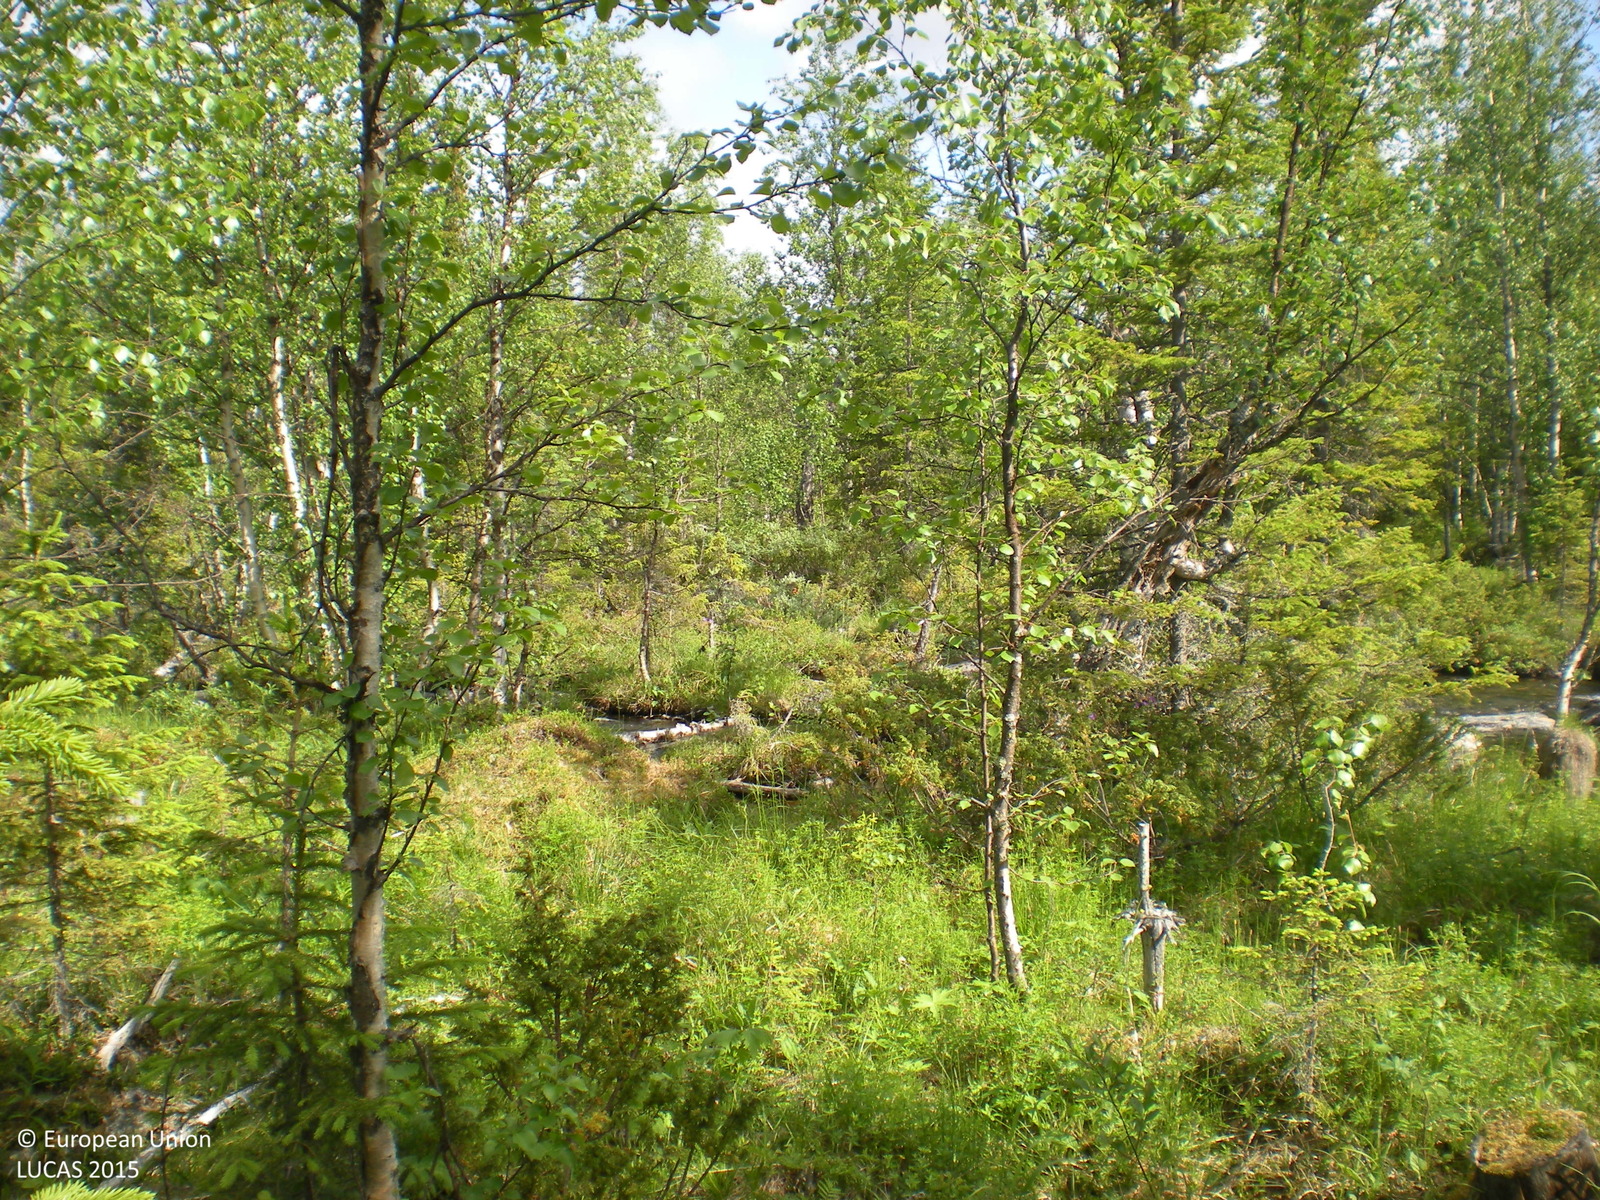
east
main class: Woodland
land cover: Spruce dominated mixed woodland
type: boreal forest
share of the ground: 50 - 75 %
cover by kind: broadleaved forest trees 50 %, coniferous forest trees 20 %, consolidated bare surface 15 %, herbaceous plants 10 %, shrubs 5 %
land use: Forestry
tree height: < 5 m
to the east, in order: Spruce dominated mixed woodland; Rivers and streams; Spruce dominated mixed woodland; Rivers and streams; Spruce dominated mixed woodland; Rivers and streams; Spruce dominated mixed woodland; Rivers and streams; Spruce dominated mixed woodland
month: July
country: SE
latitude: 65.5720
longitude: 16.9164
